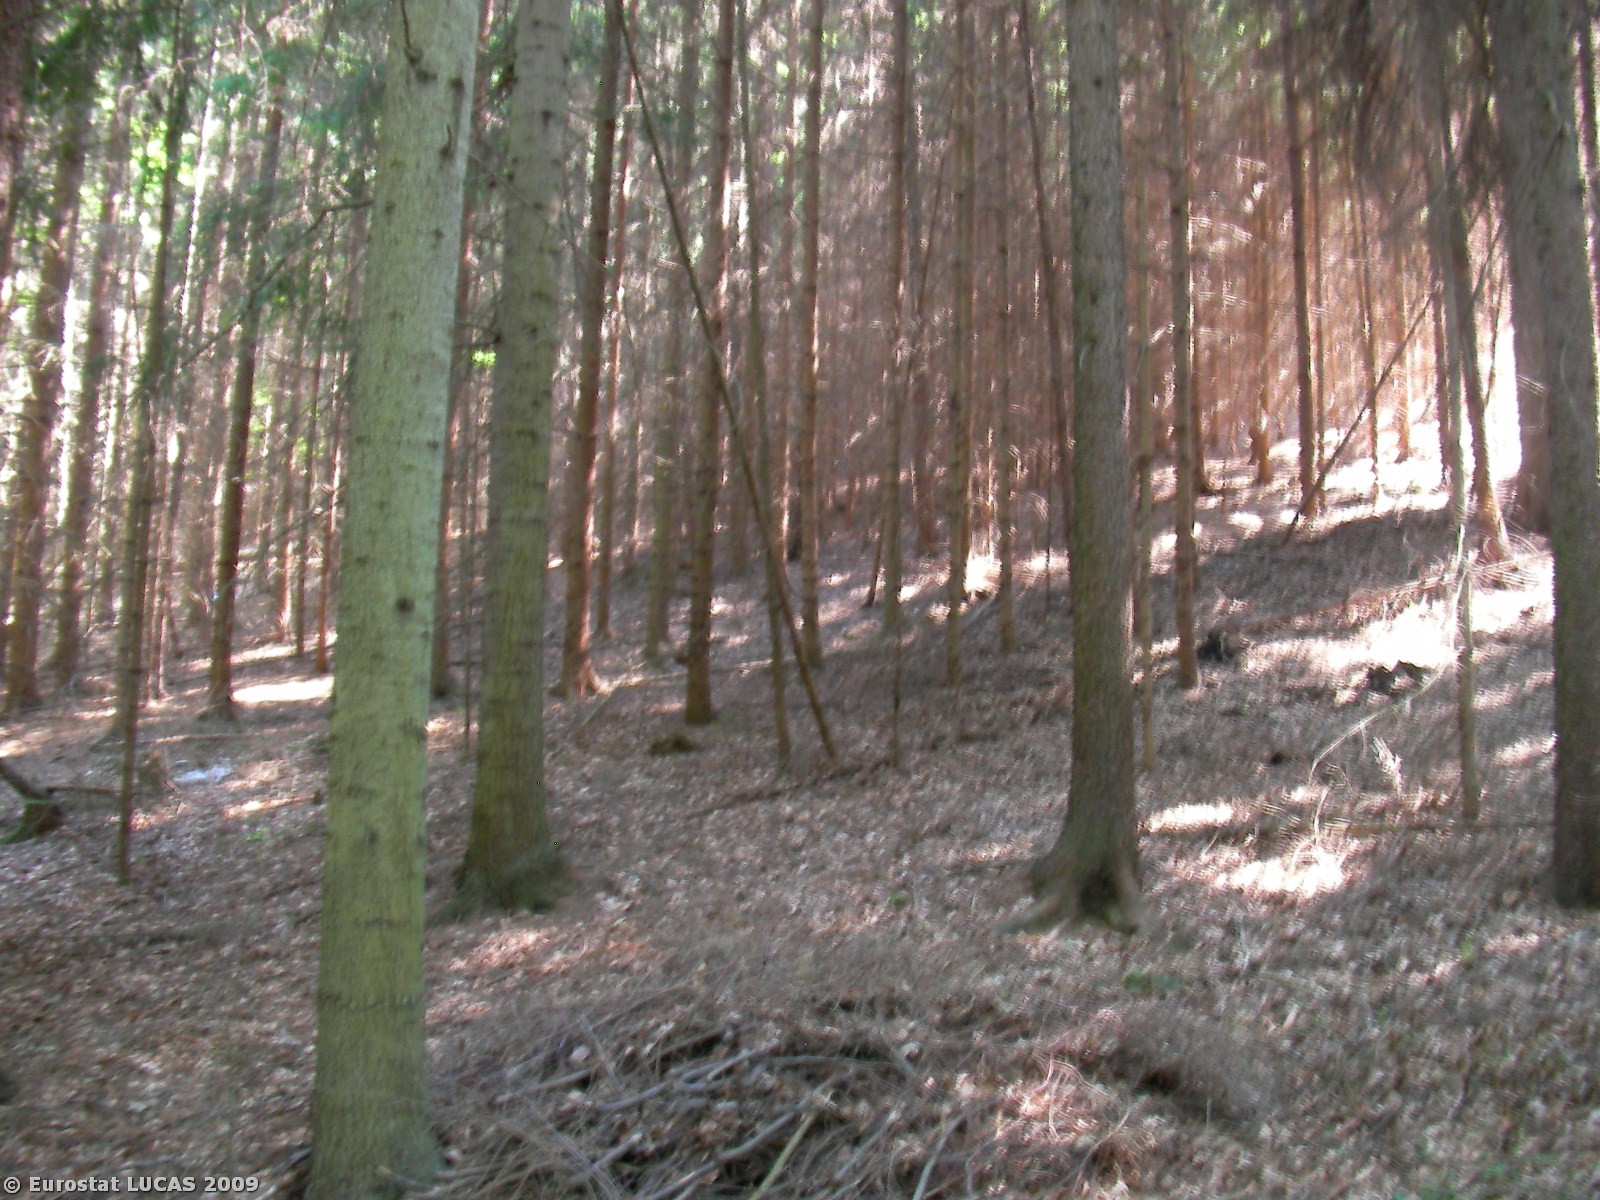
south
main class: Woodland
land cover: Mixed woodland
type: hemiboreal forest and nemoral coniferous forest and mixed broadleaved-coniferous forest
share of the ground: > 75 %
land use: Forestry
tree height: > 5 m
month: June
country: AT
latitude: 47.2339
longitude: 15.5879
